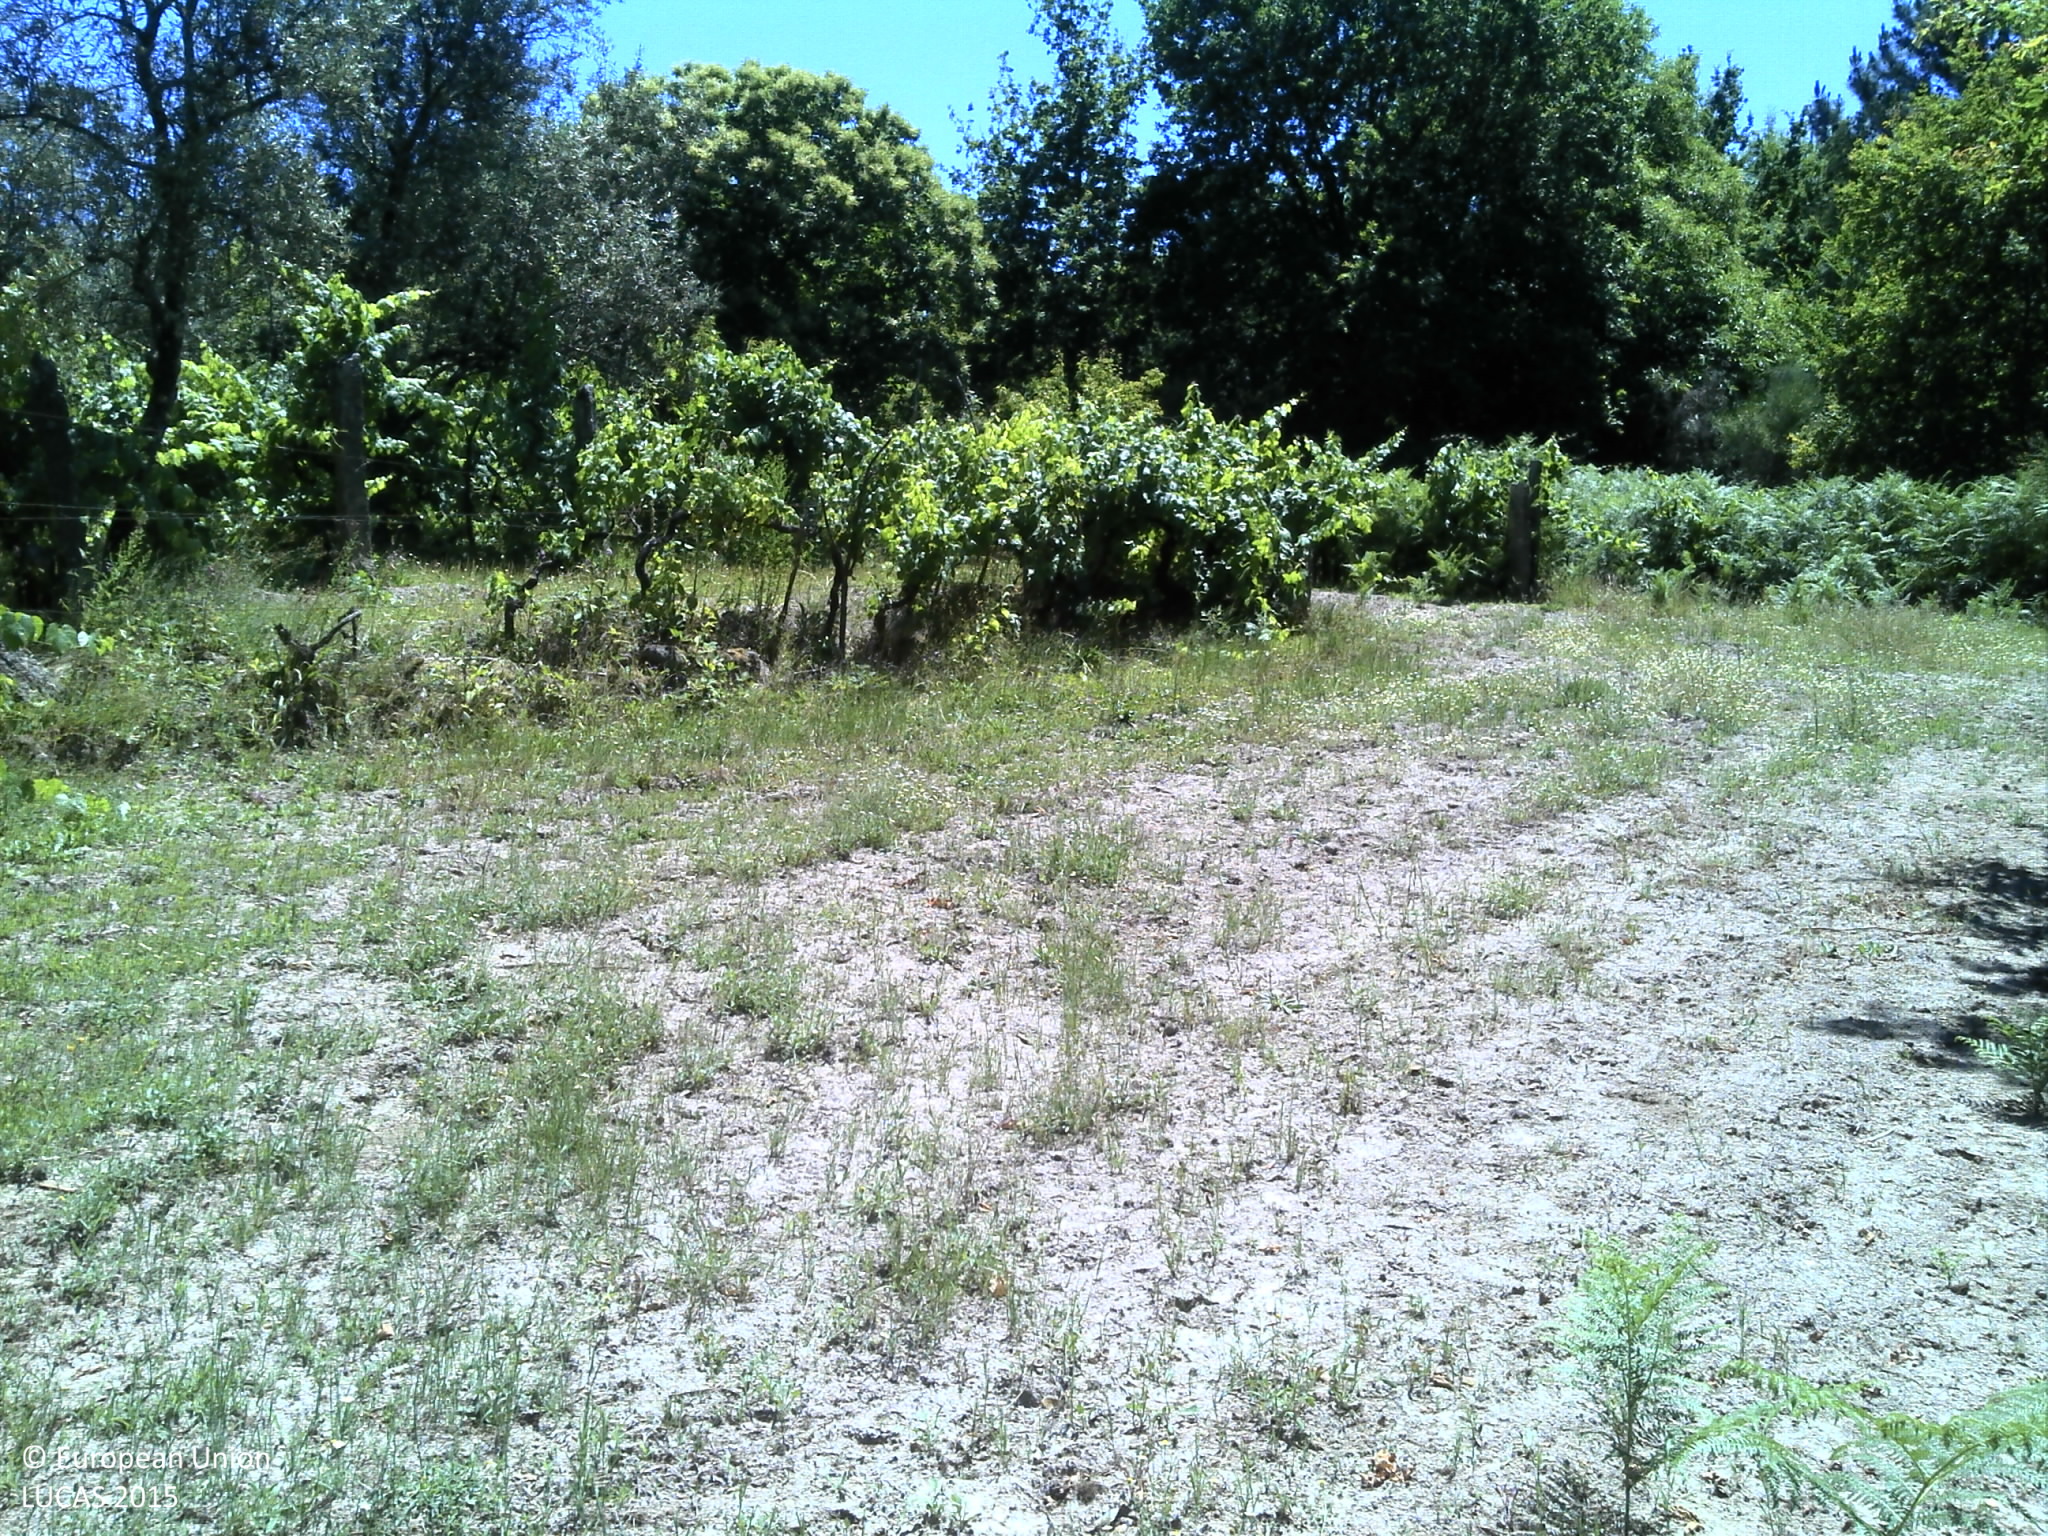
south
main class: Grassland
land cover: Grassland with sparse tree/shrub cover
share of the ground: 25 - 50 %
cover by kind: herbaceous plants 50 %, unconsolidated bare surface 35 %, shrubs 10 %, broadleaved forest trees 5 %
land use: Semi-natural and natural areas not in use
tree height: > 5 m
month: June
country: PT
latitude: 40.6657
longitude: -8.0490
